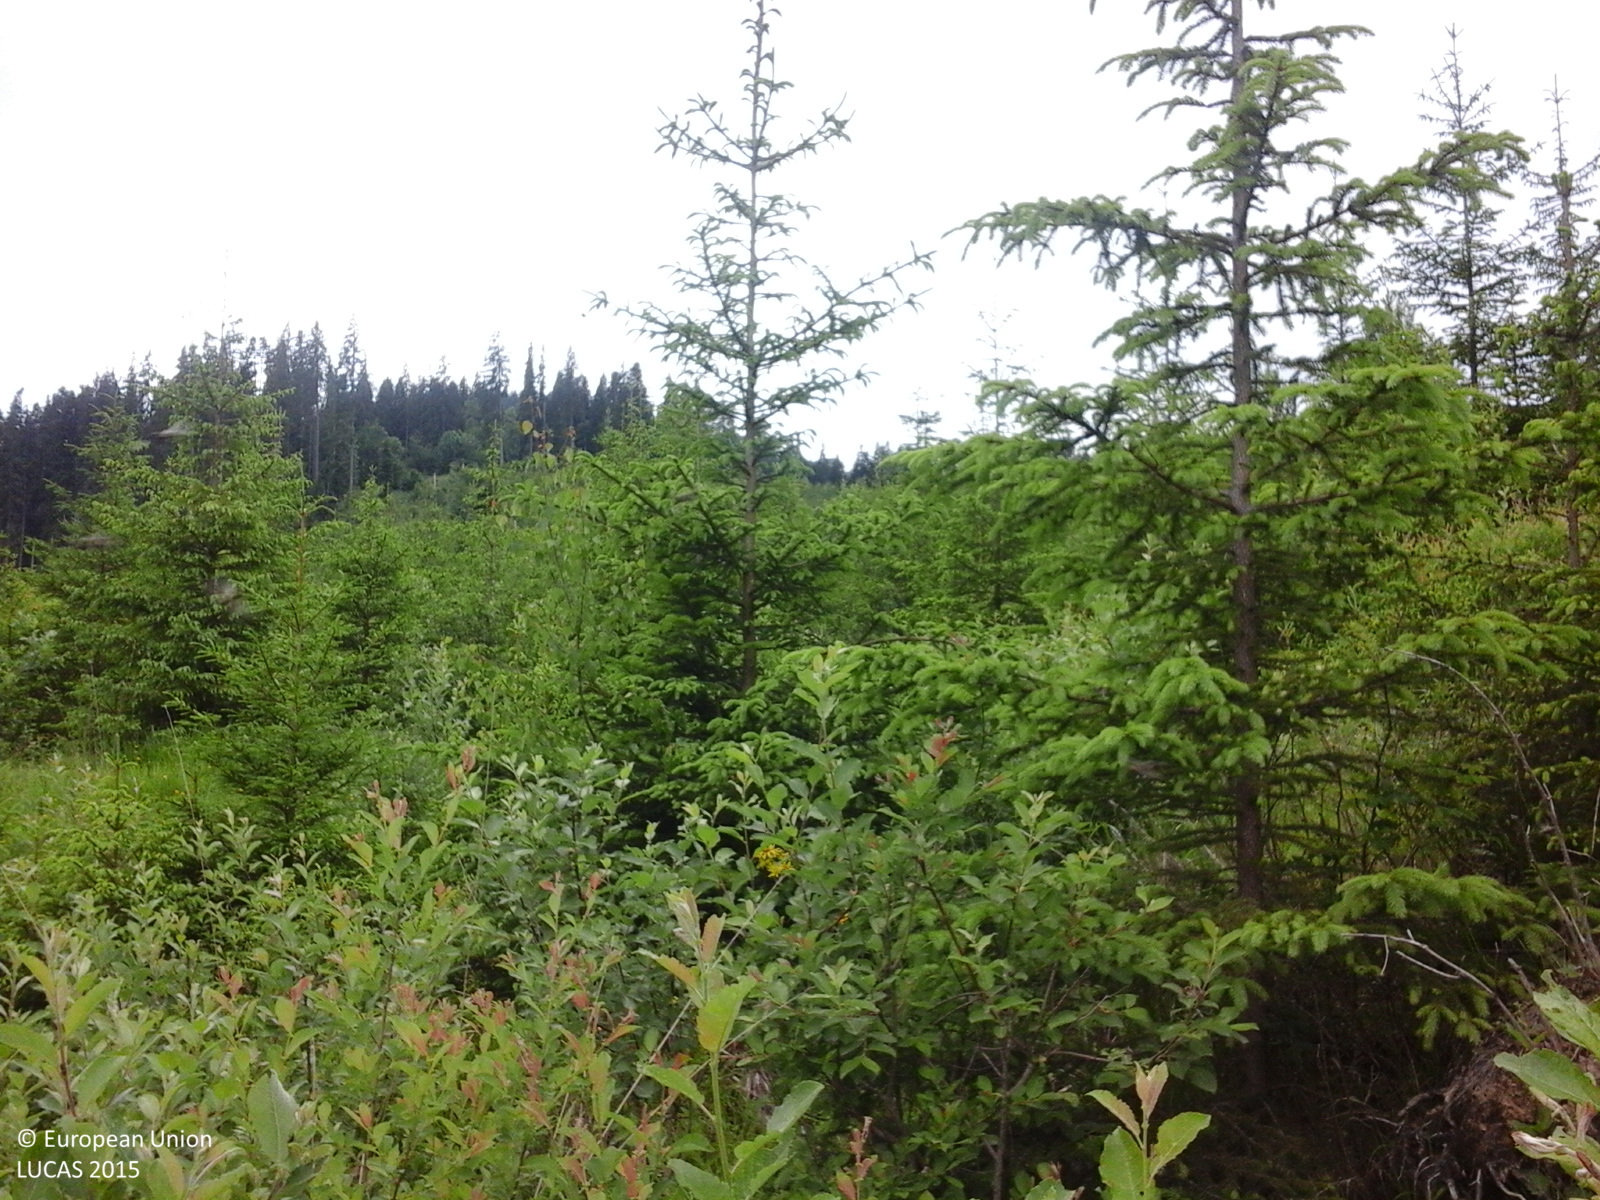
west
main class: Woodland
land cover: Spruce dominated coniferous woodland
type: alpine coniferous forest
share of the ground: > 75 %
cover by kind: coniferous forest trees 70 %, herbaceous plants 20 %, shrubs 10 %
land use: Forestry
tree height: < 5 m
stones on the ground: < 10 %
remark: Clear cut
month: June
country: RO
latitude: 47.7221
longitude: 25.3791
